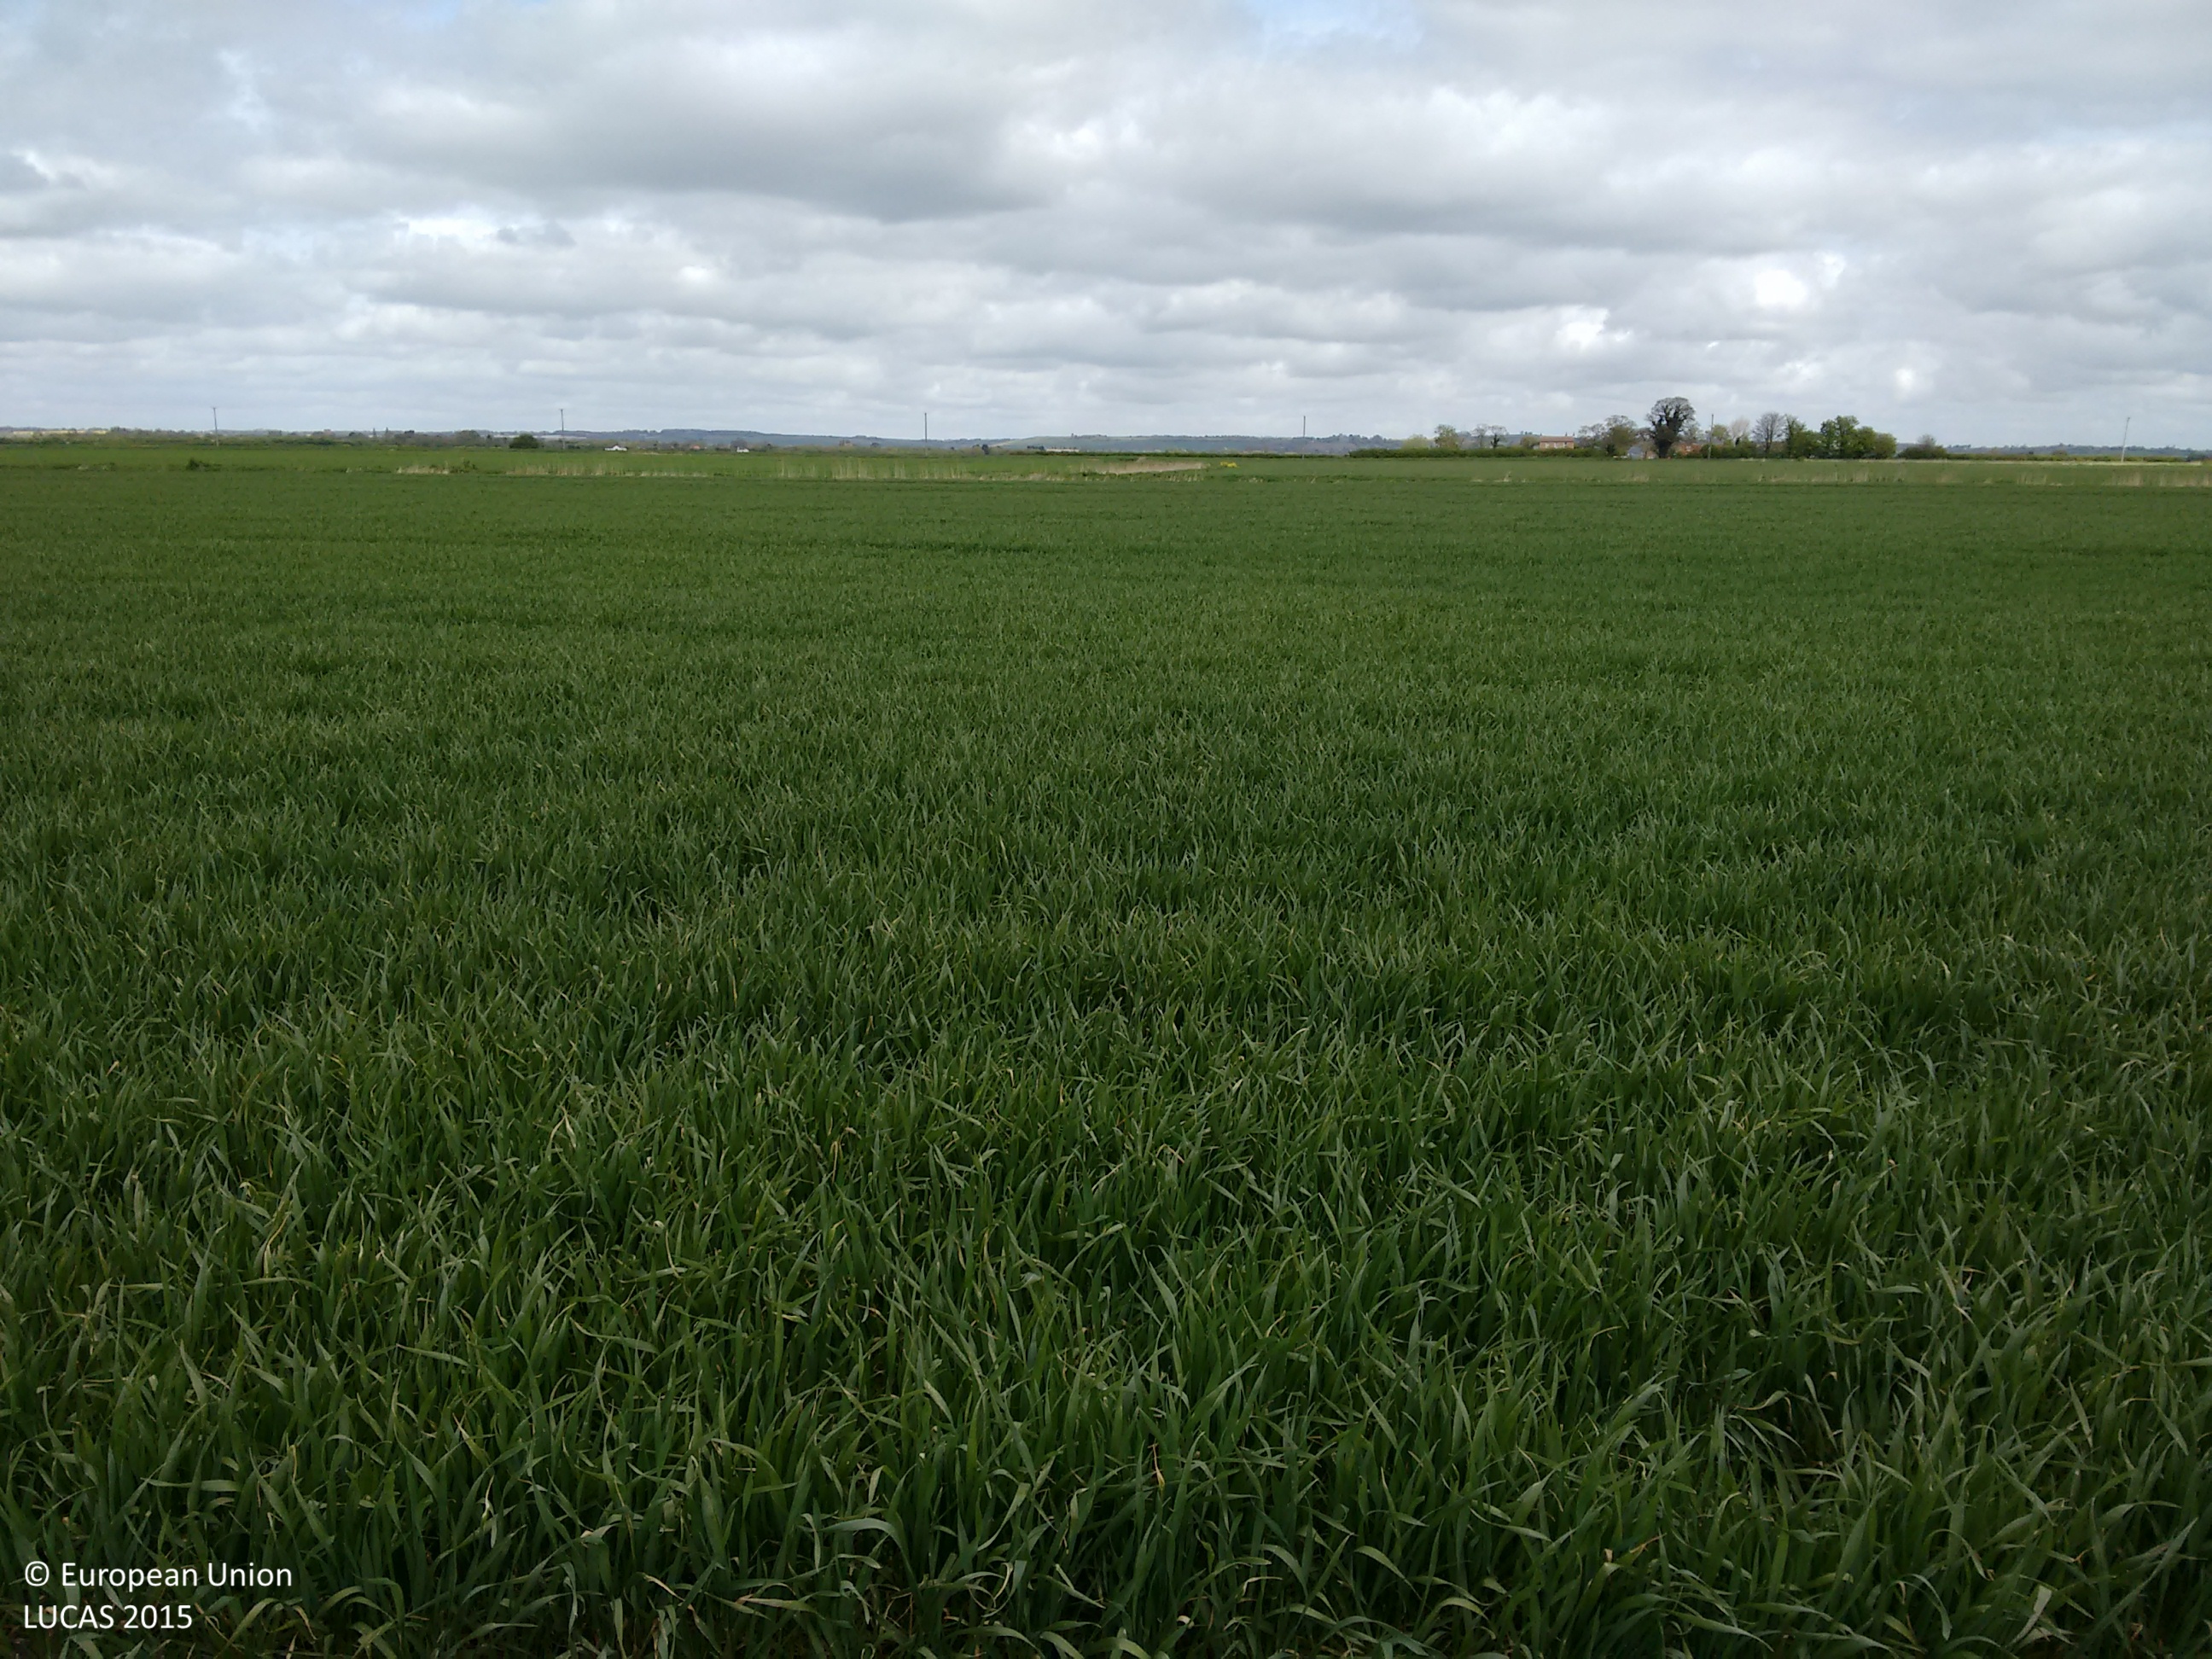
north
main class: Cropland
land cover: Common wheat
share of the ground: > 75 %
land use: Agriculture (excluding fallow land and kitchen gardens)
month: May
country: GB
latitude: 53.0988
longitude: 0.0367
